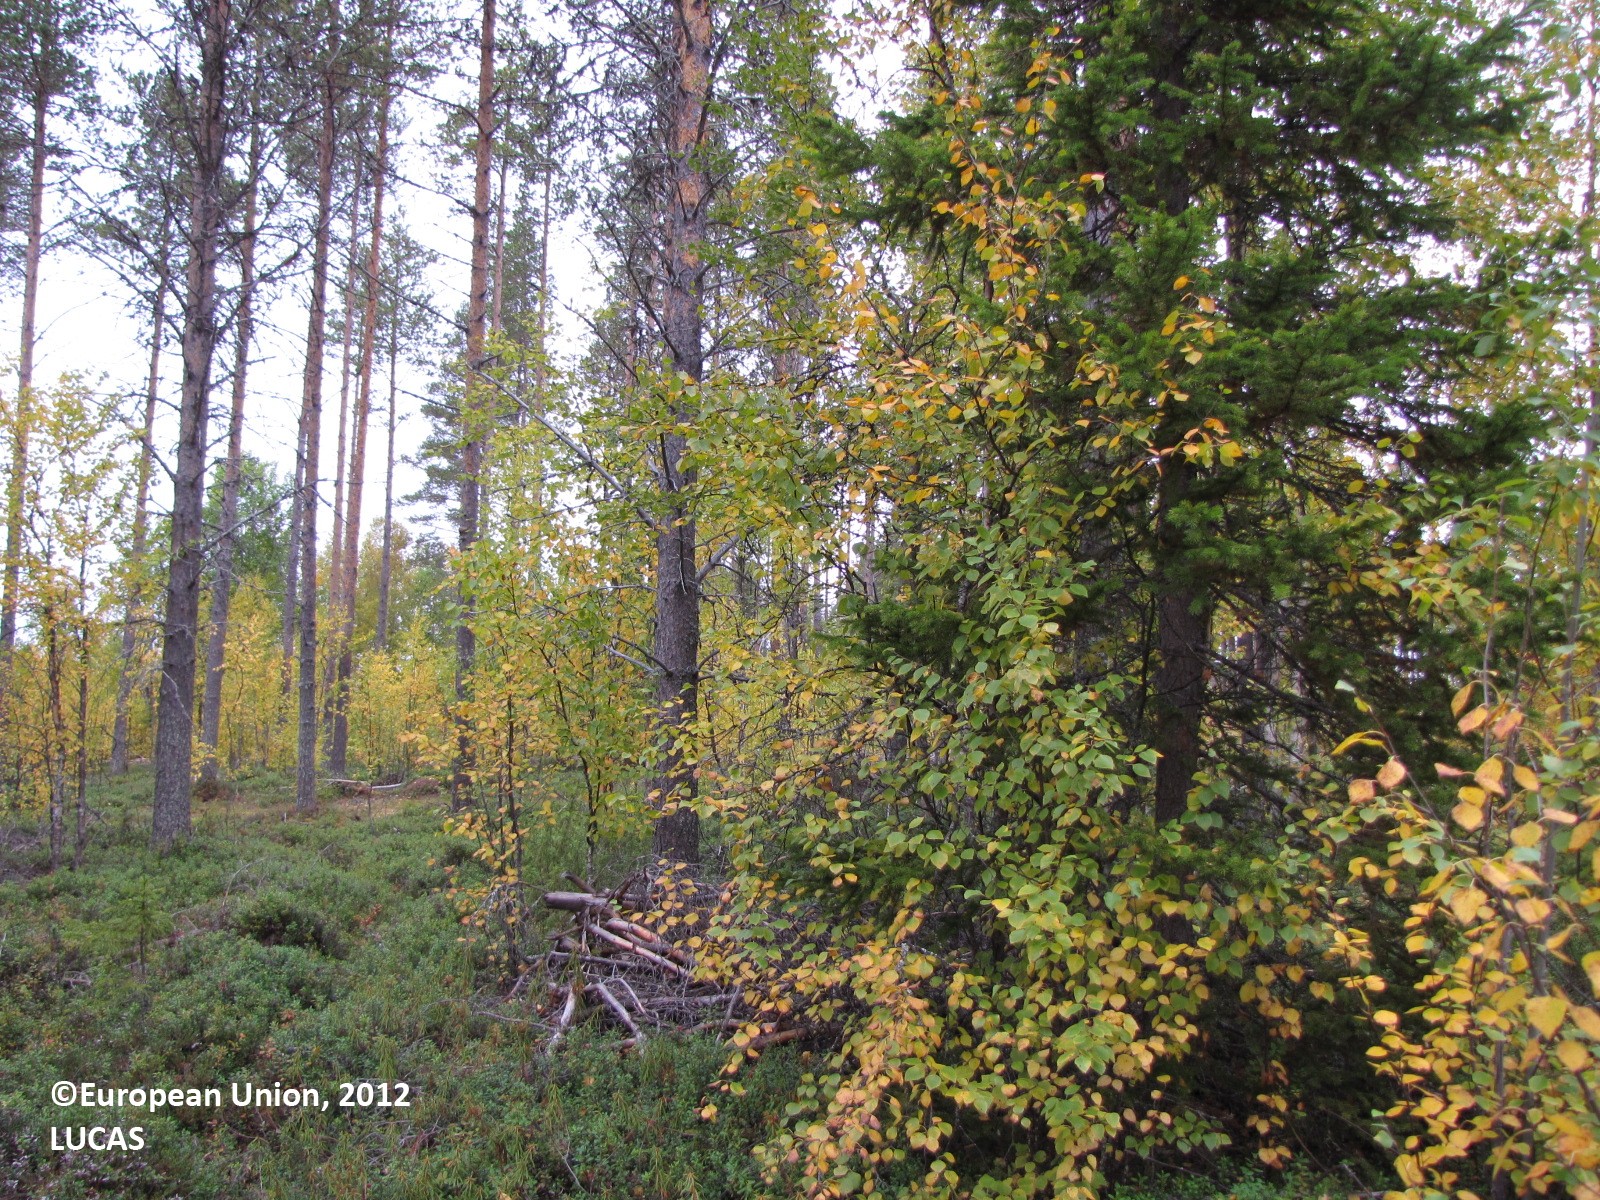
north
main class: Woodland
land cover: Broadleaved woodland
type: boreal forest
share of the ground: 25 - 50 %
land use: Energy production
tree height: < 5 m
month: September
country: FI
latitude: 67.1947
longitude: 25.1909
